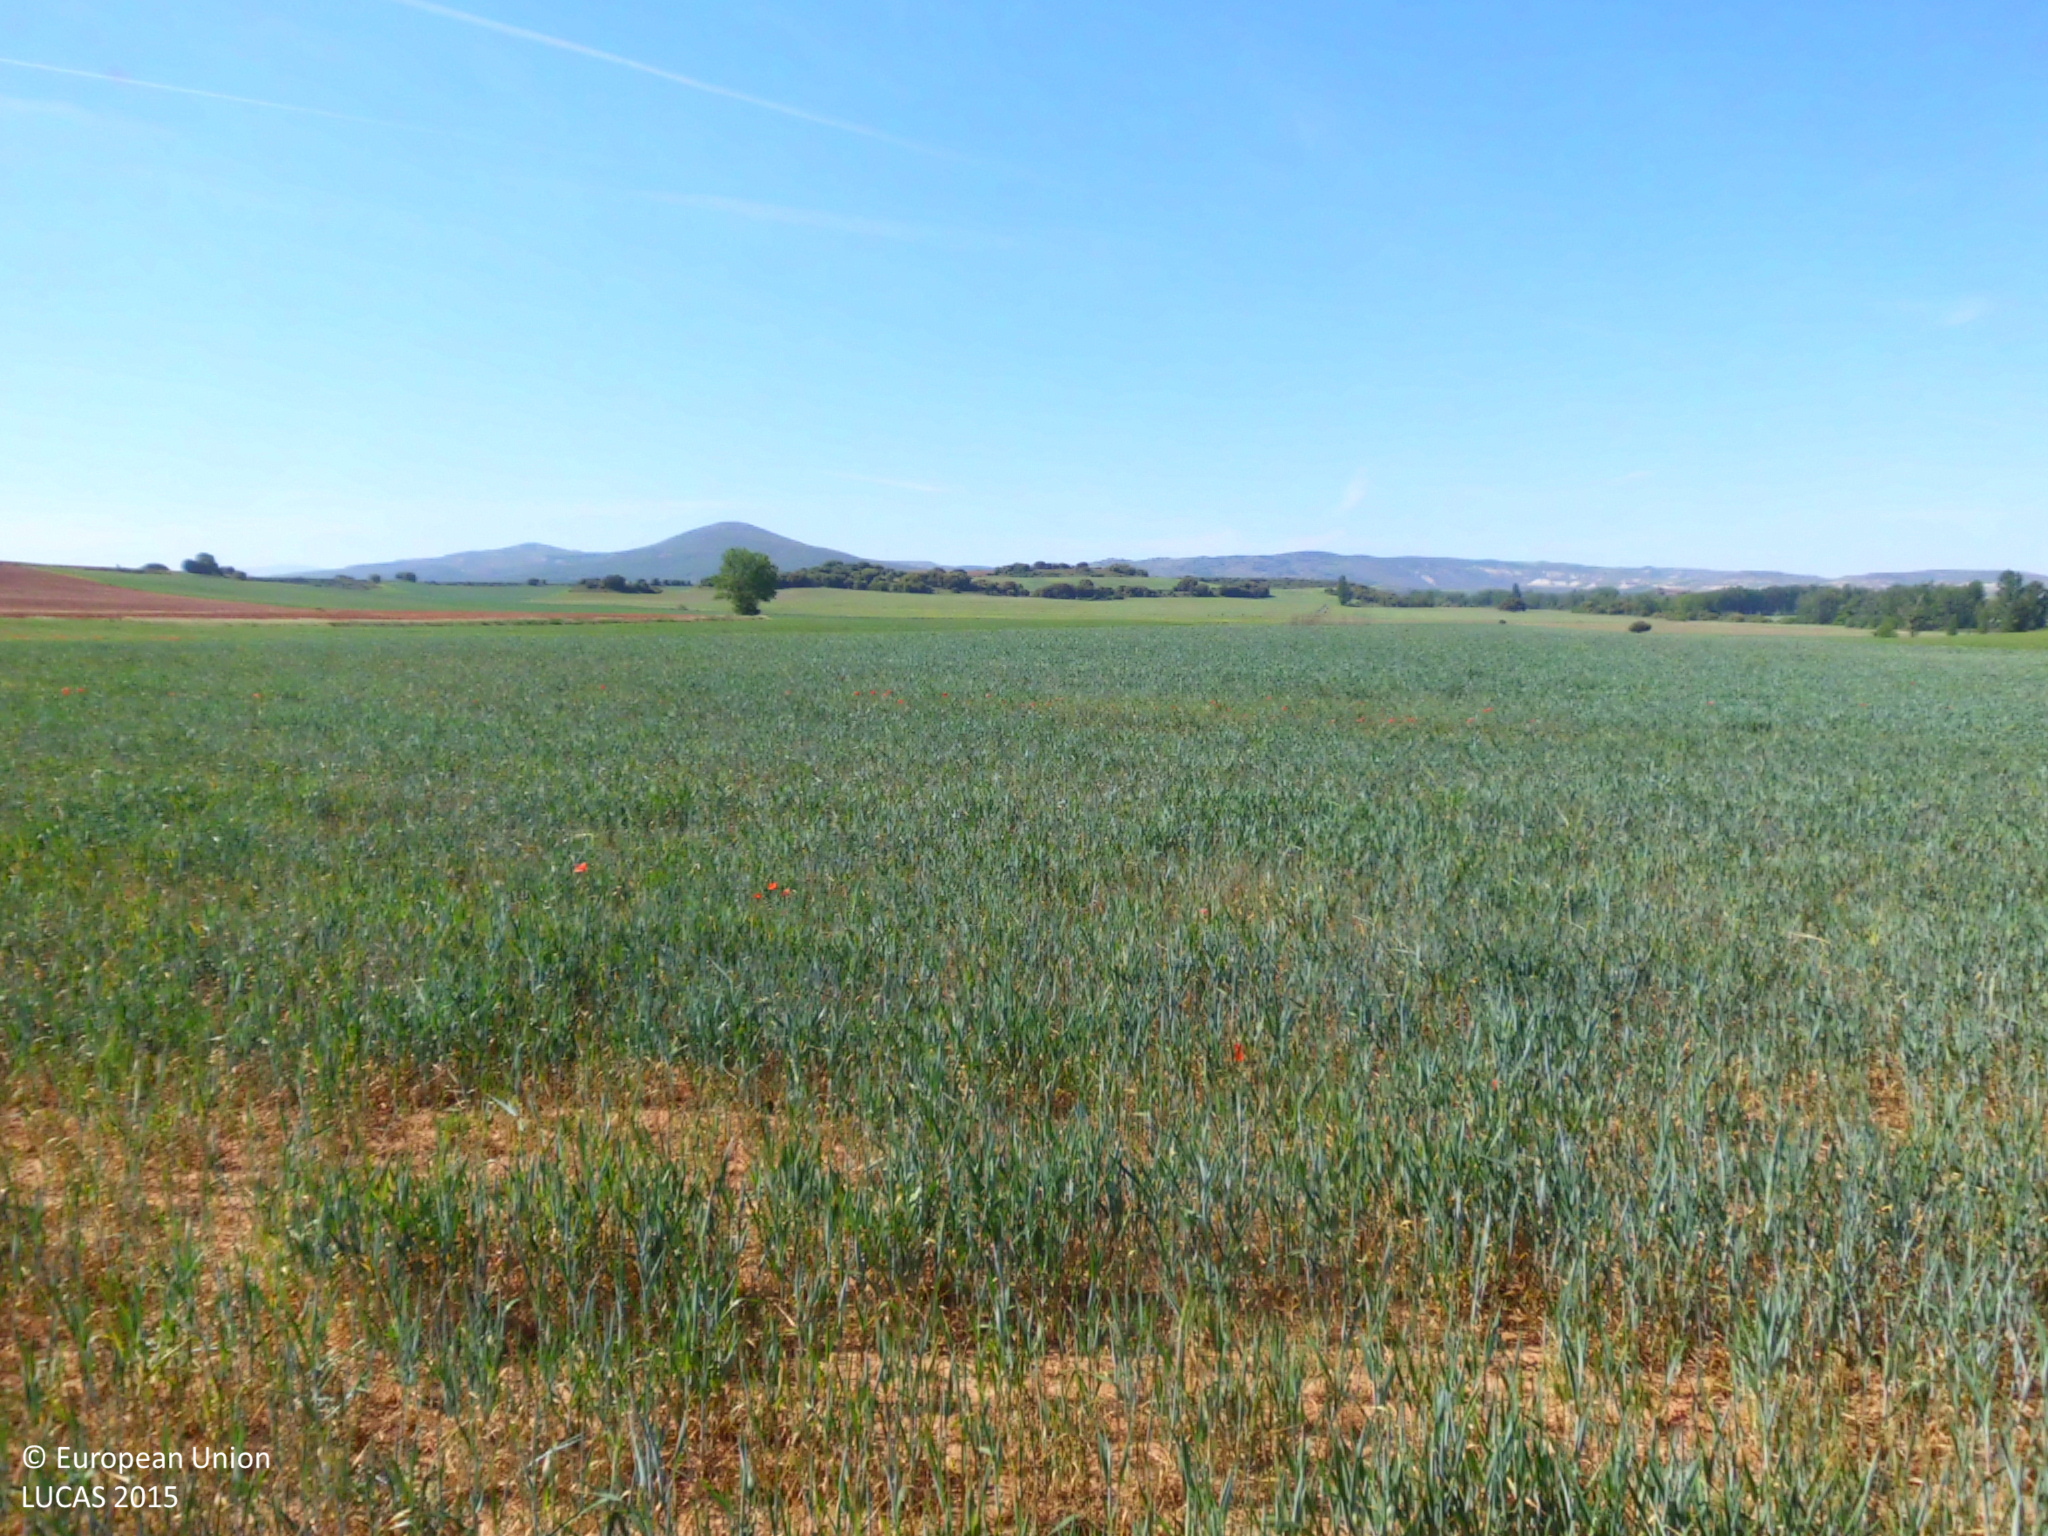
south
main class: Cropland
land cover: Common wheat
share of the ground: 25 - 50 %
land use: Agriculture (excluding fallow land and kitchen gardens)
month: May
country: ES
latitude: 42.6349
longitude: -3.4126
